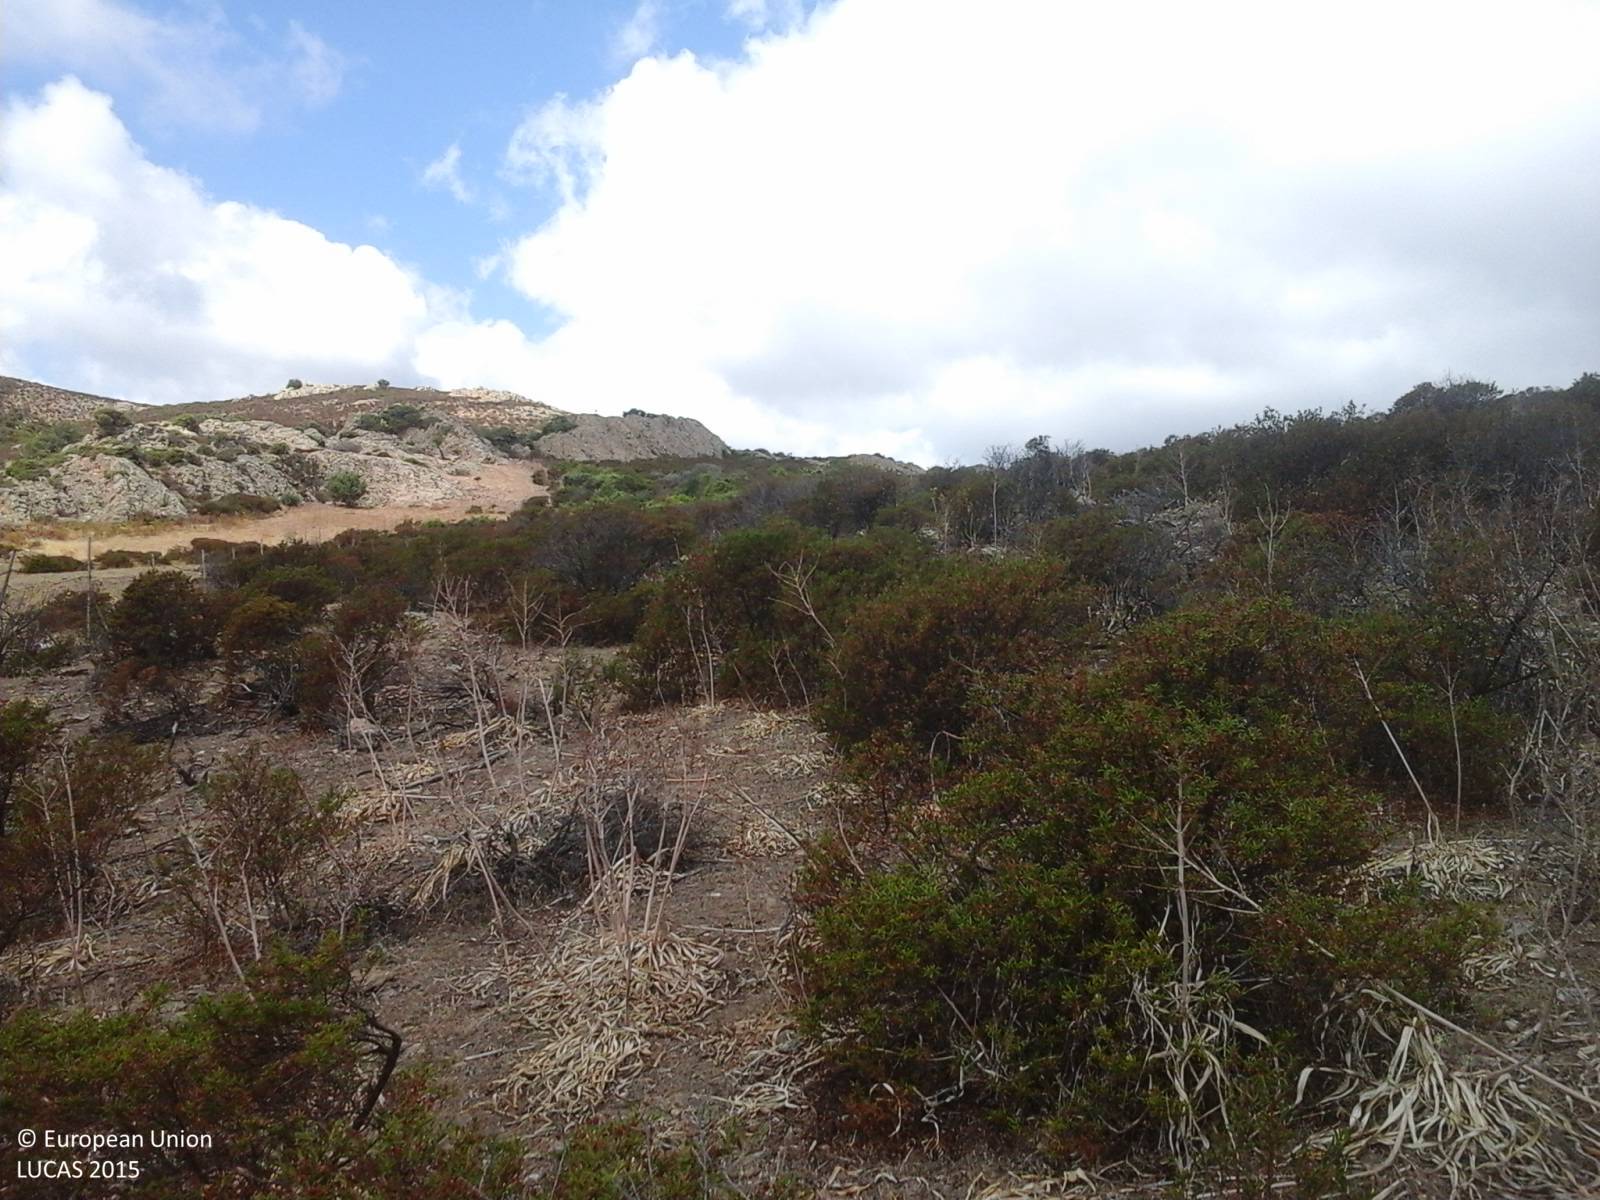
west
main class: Shrubland
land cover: Shrubland without tree cover
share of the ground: > 75 %
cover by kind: shrubs 80 %, herbaceous plants 10 %, unconsolidated bare surface 10 %
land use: Agriculture (excluding fallow land and kitchen gardens)
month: August
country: IT
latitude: 39.7048
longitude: 9.5246
